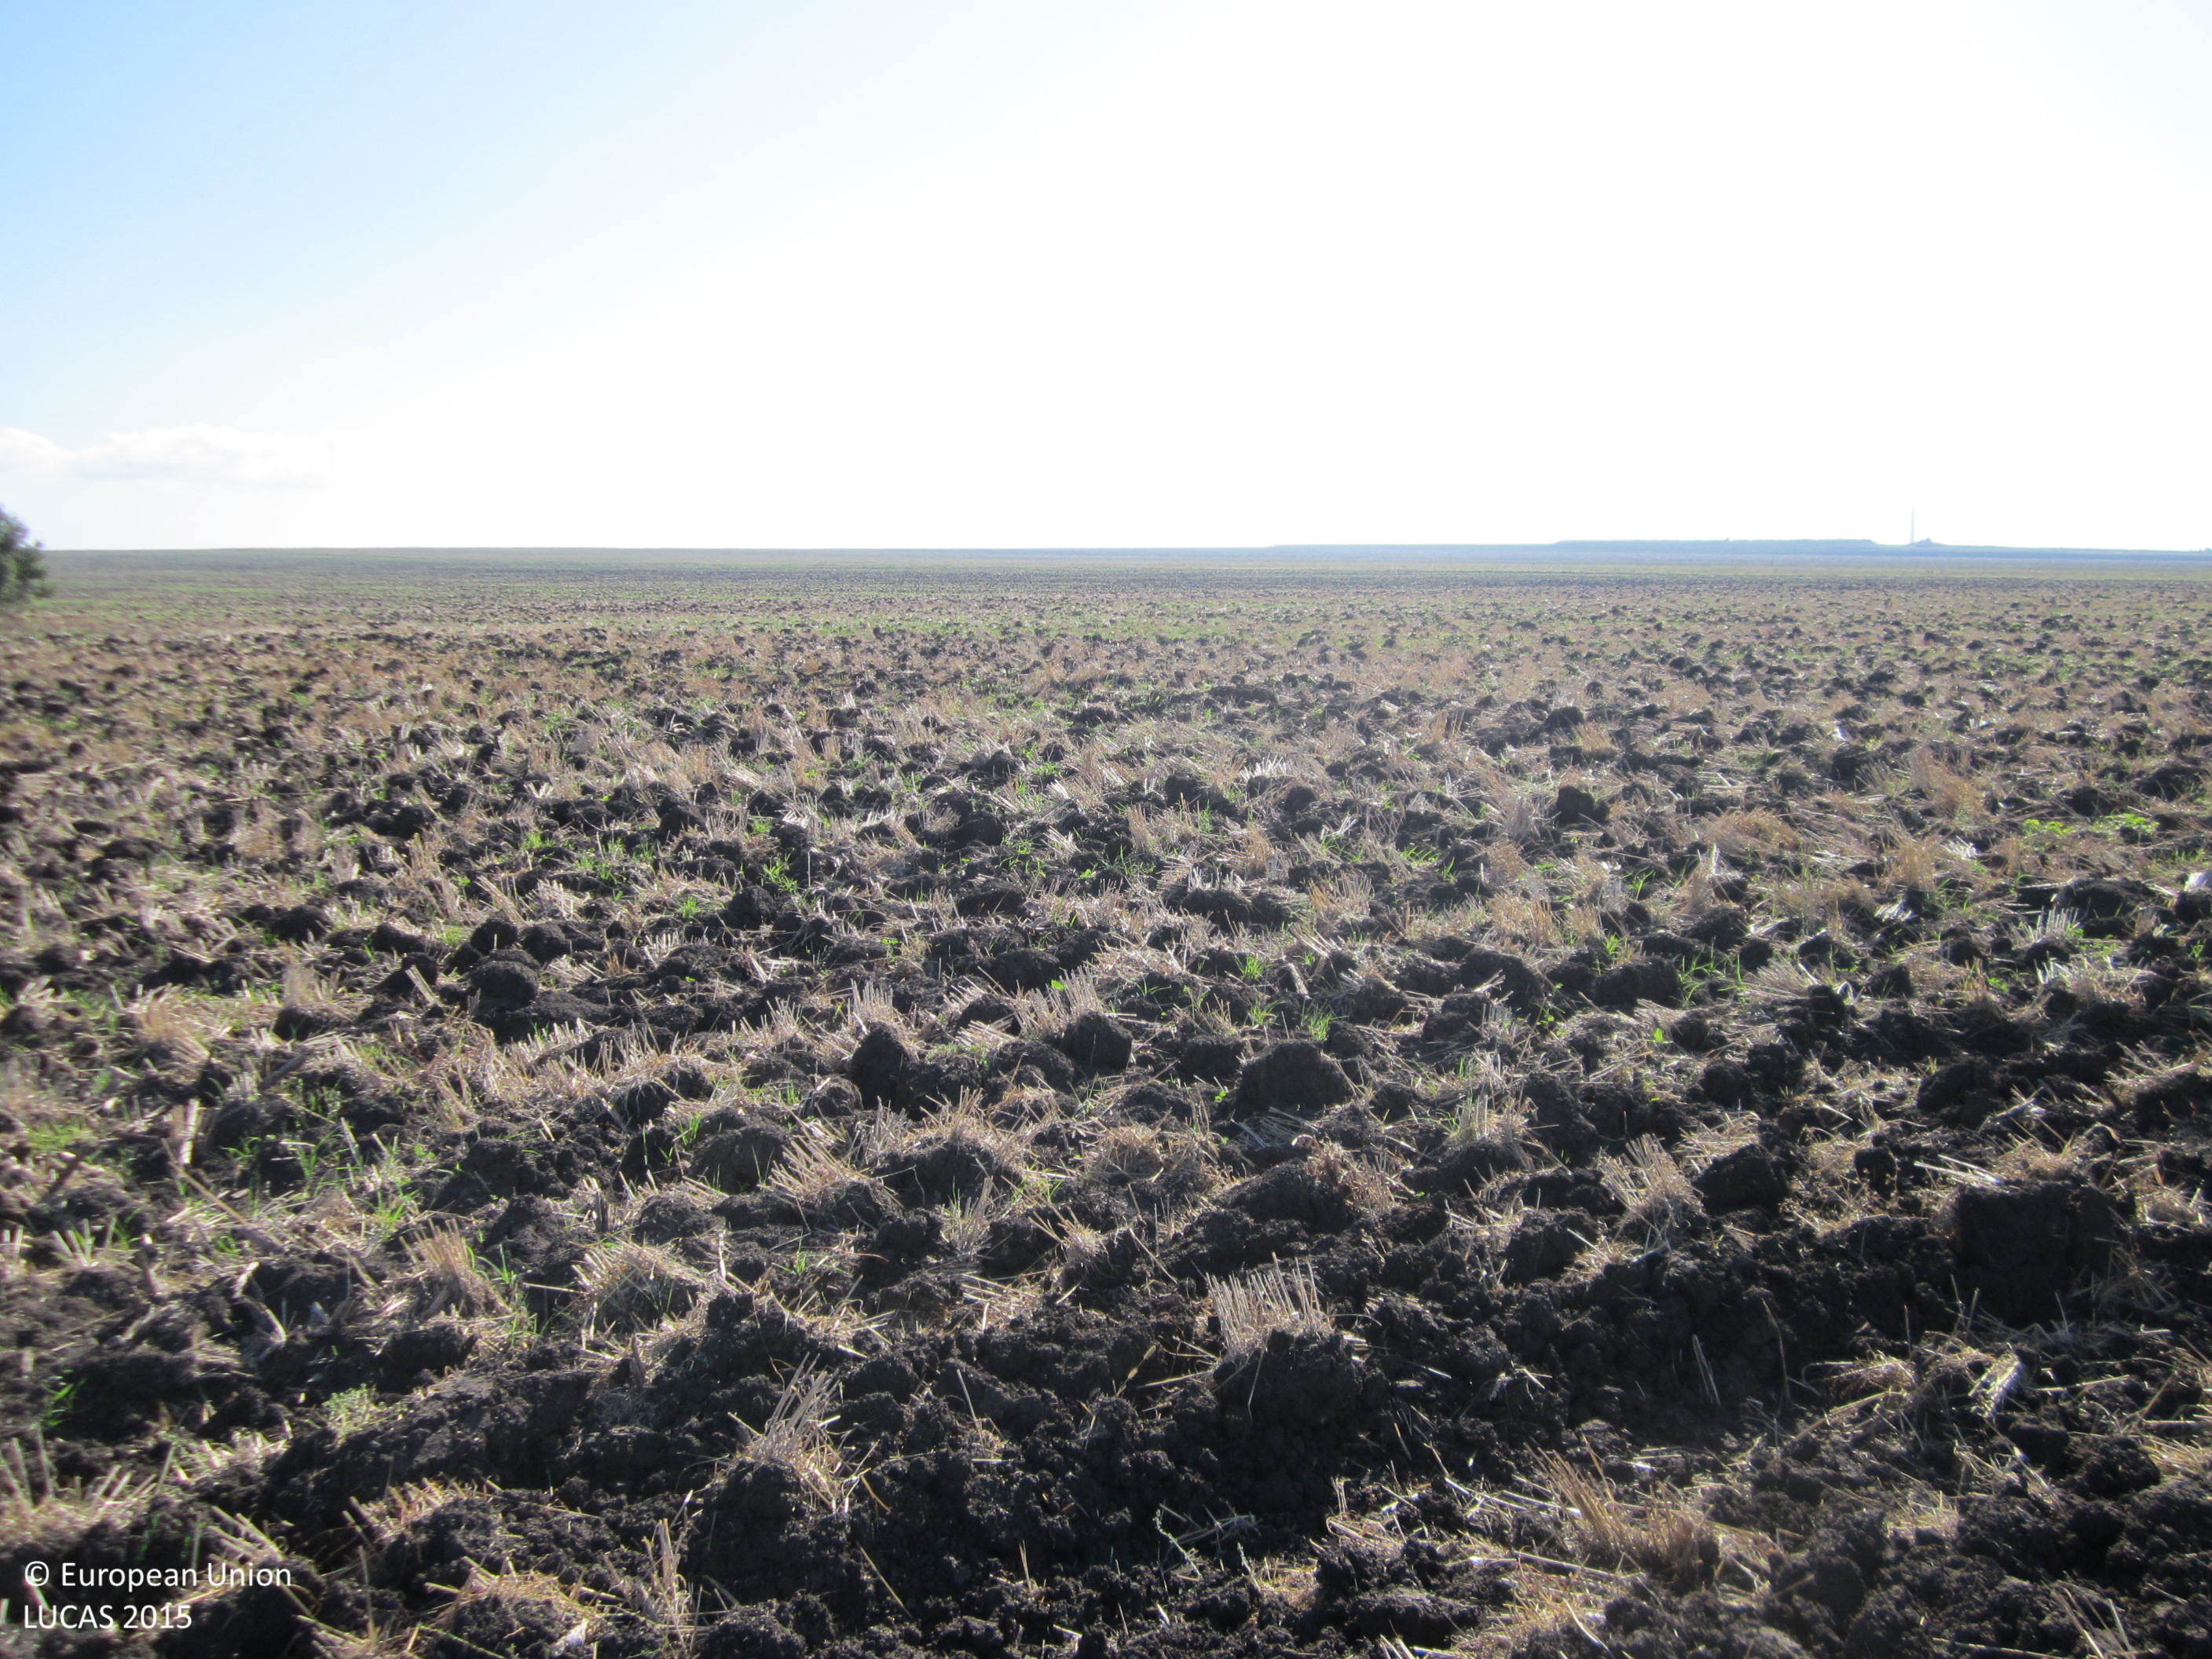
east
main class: Cropland
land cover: Common wheat
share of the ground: < 10 %
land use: Agriculture (excluding fallow land and kitchen gardens)
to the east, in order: Common wheat
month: September
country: BG
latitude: 42.5404
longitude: 27.3687
